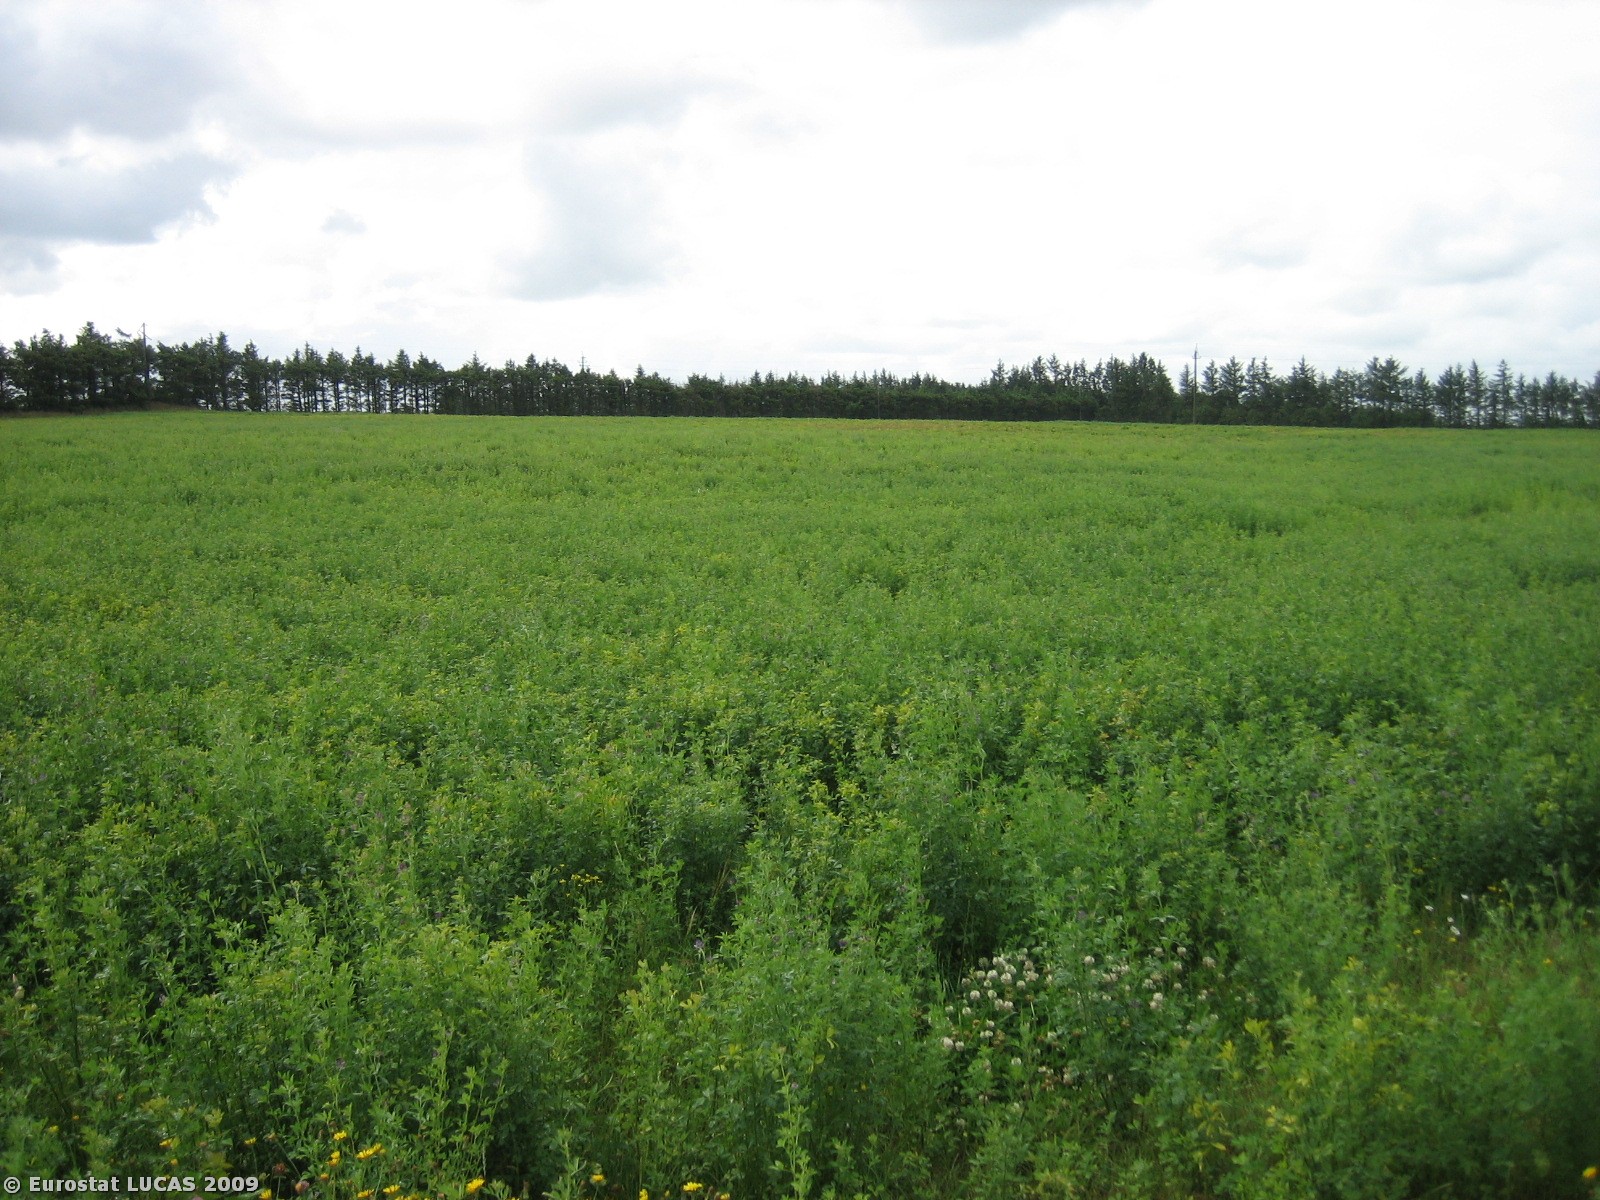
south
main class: Cropland
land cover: Clovers
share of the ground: > 75 %
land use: Agriculture (excluding fallow land and kitchen gardens)
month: July
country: DK
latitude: 55.8372
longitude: 8.4846
